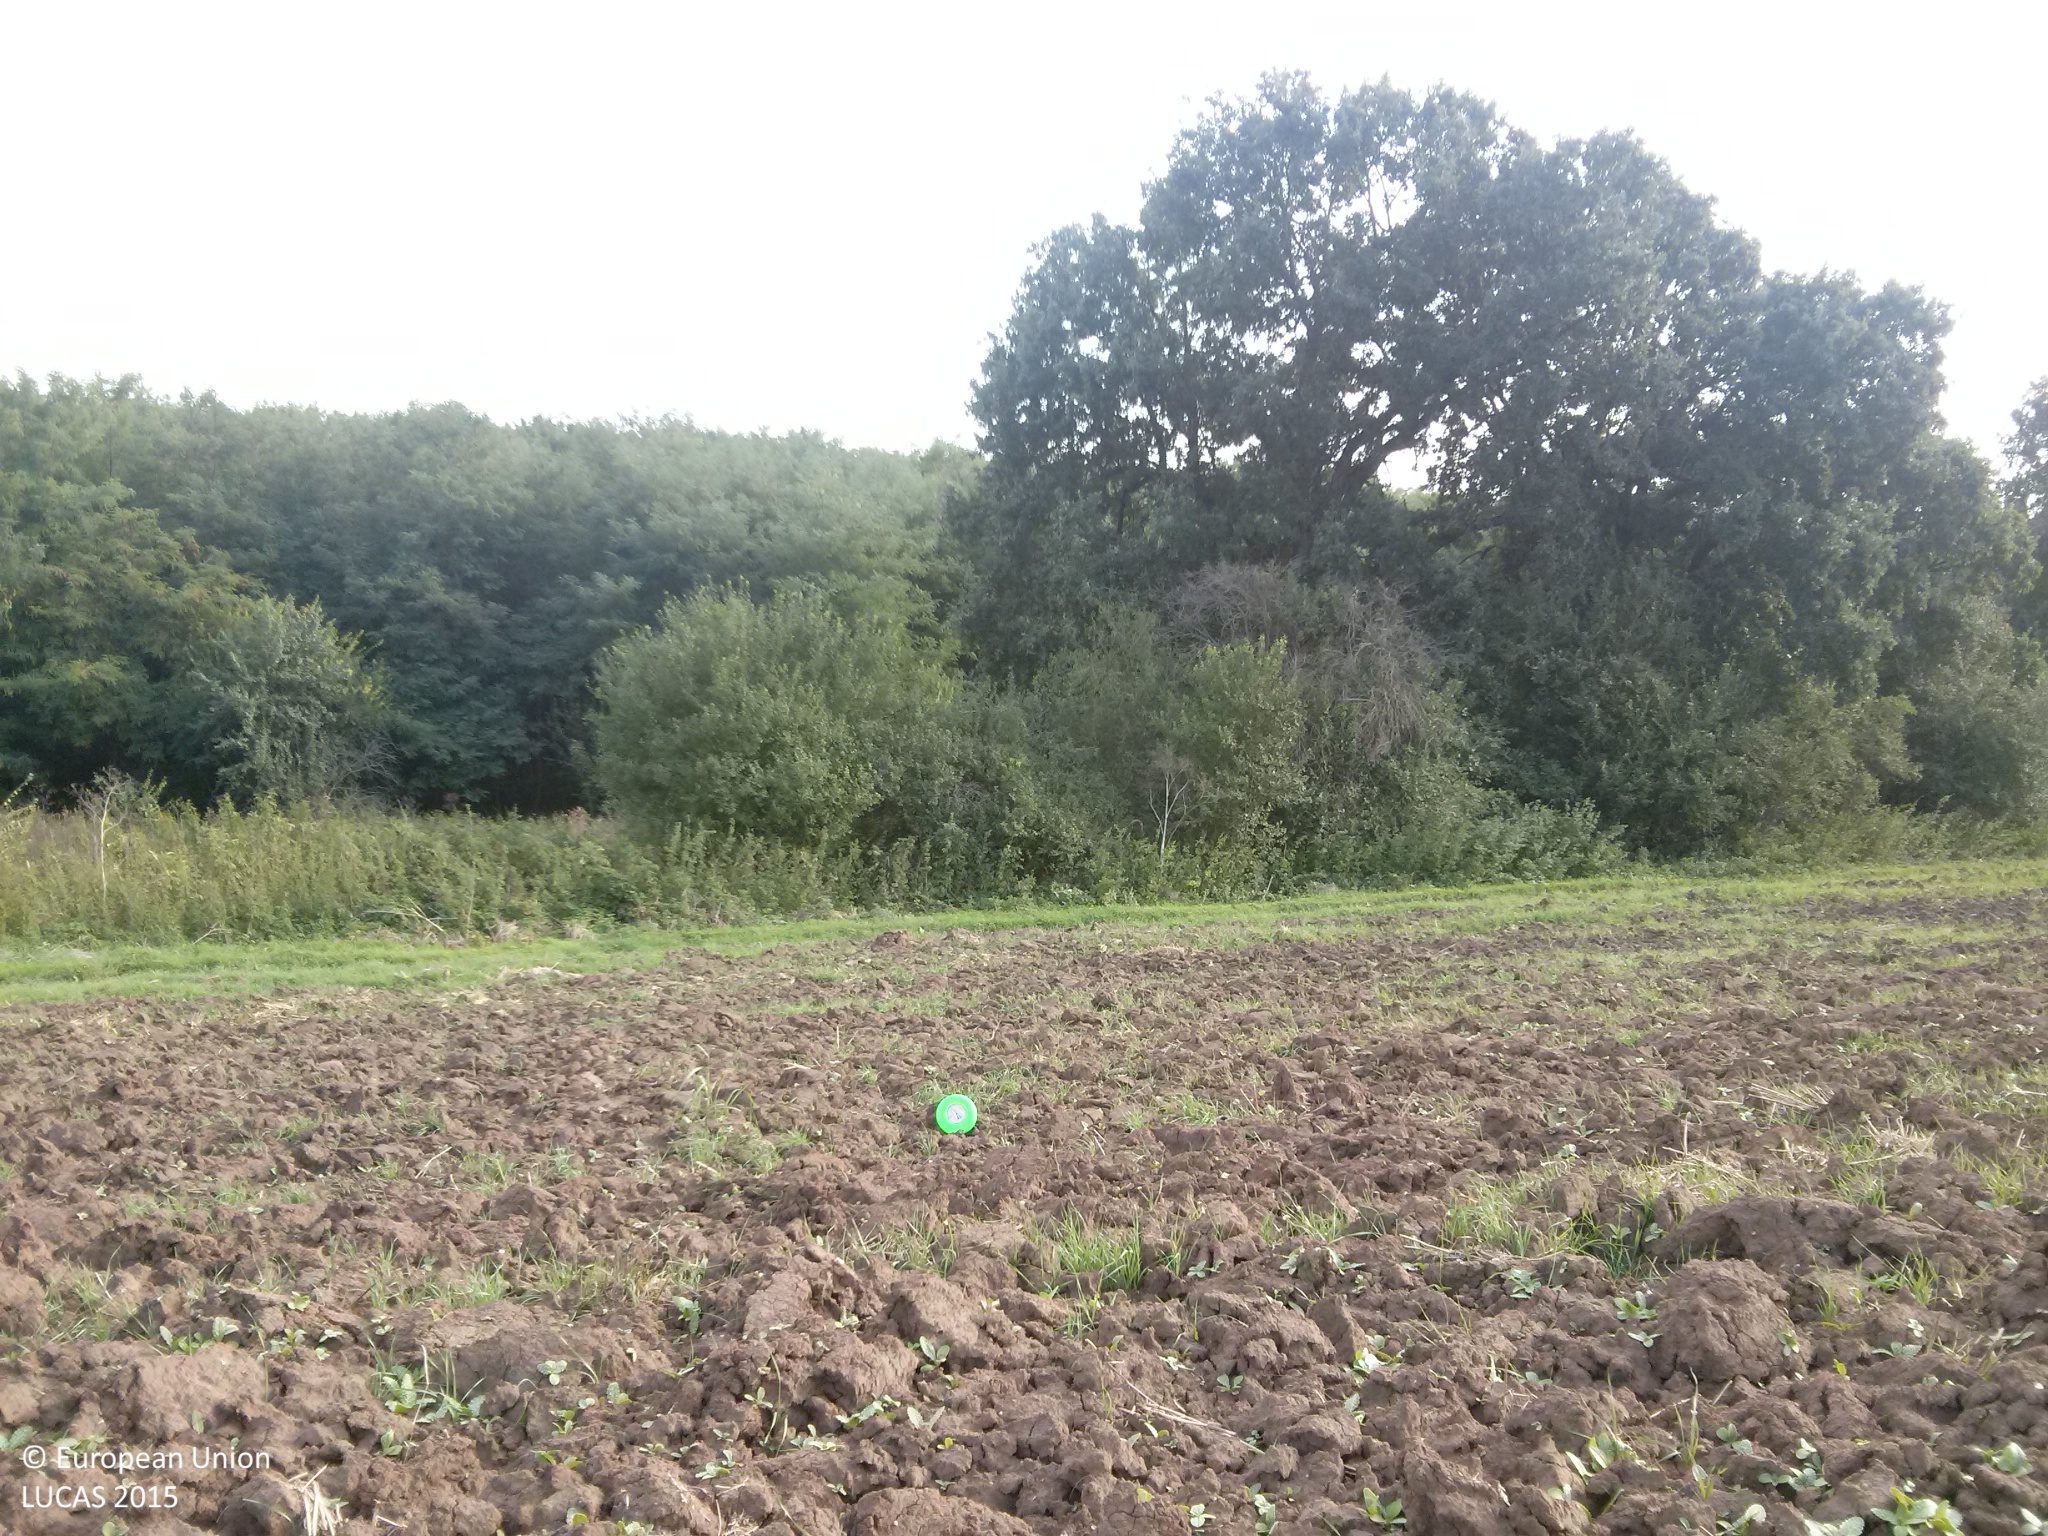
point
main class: Cropland
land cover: Common wheat
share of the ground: < 10 %
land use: Agriculture (excluding fallow land and kitchen gardens)
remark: Harvested field
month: September
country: BG
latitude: 43.7265
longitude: 26.3281
